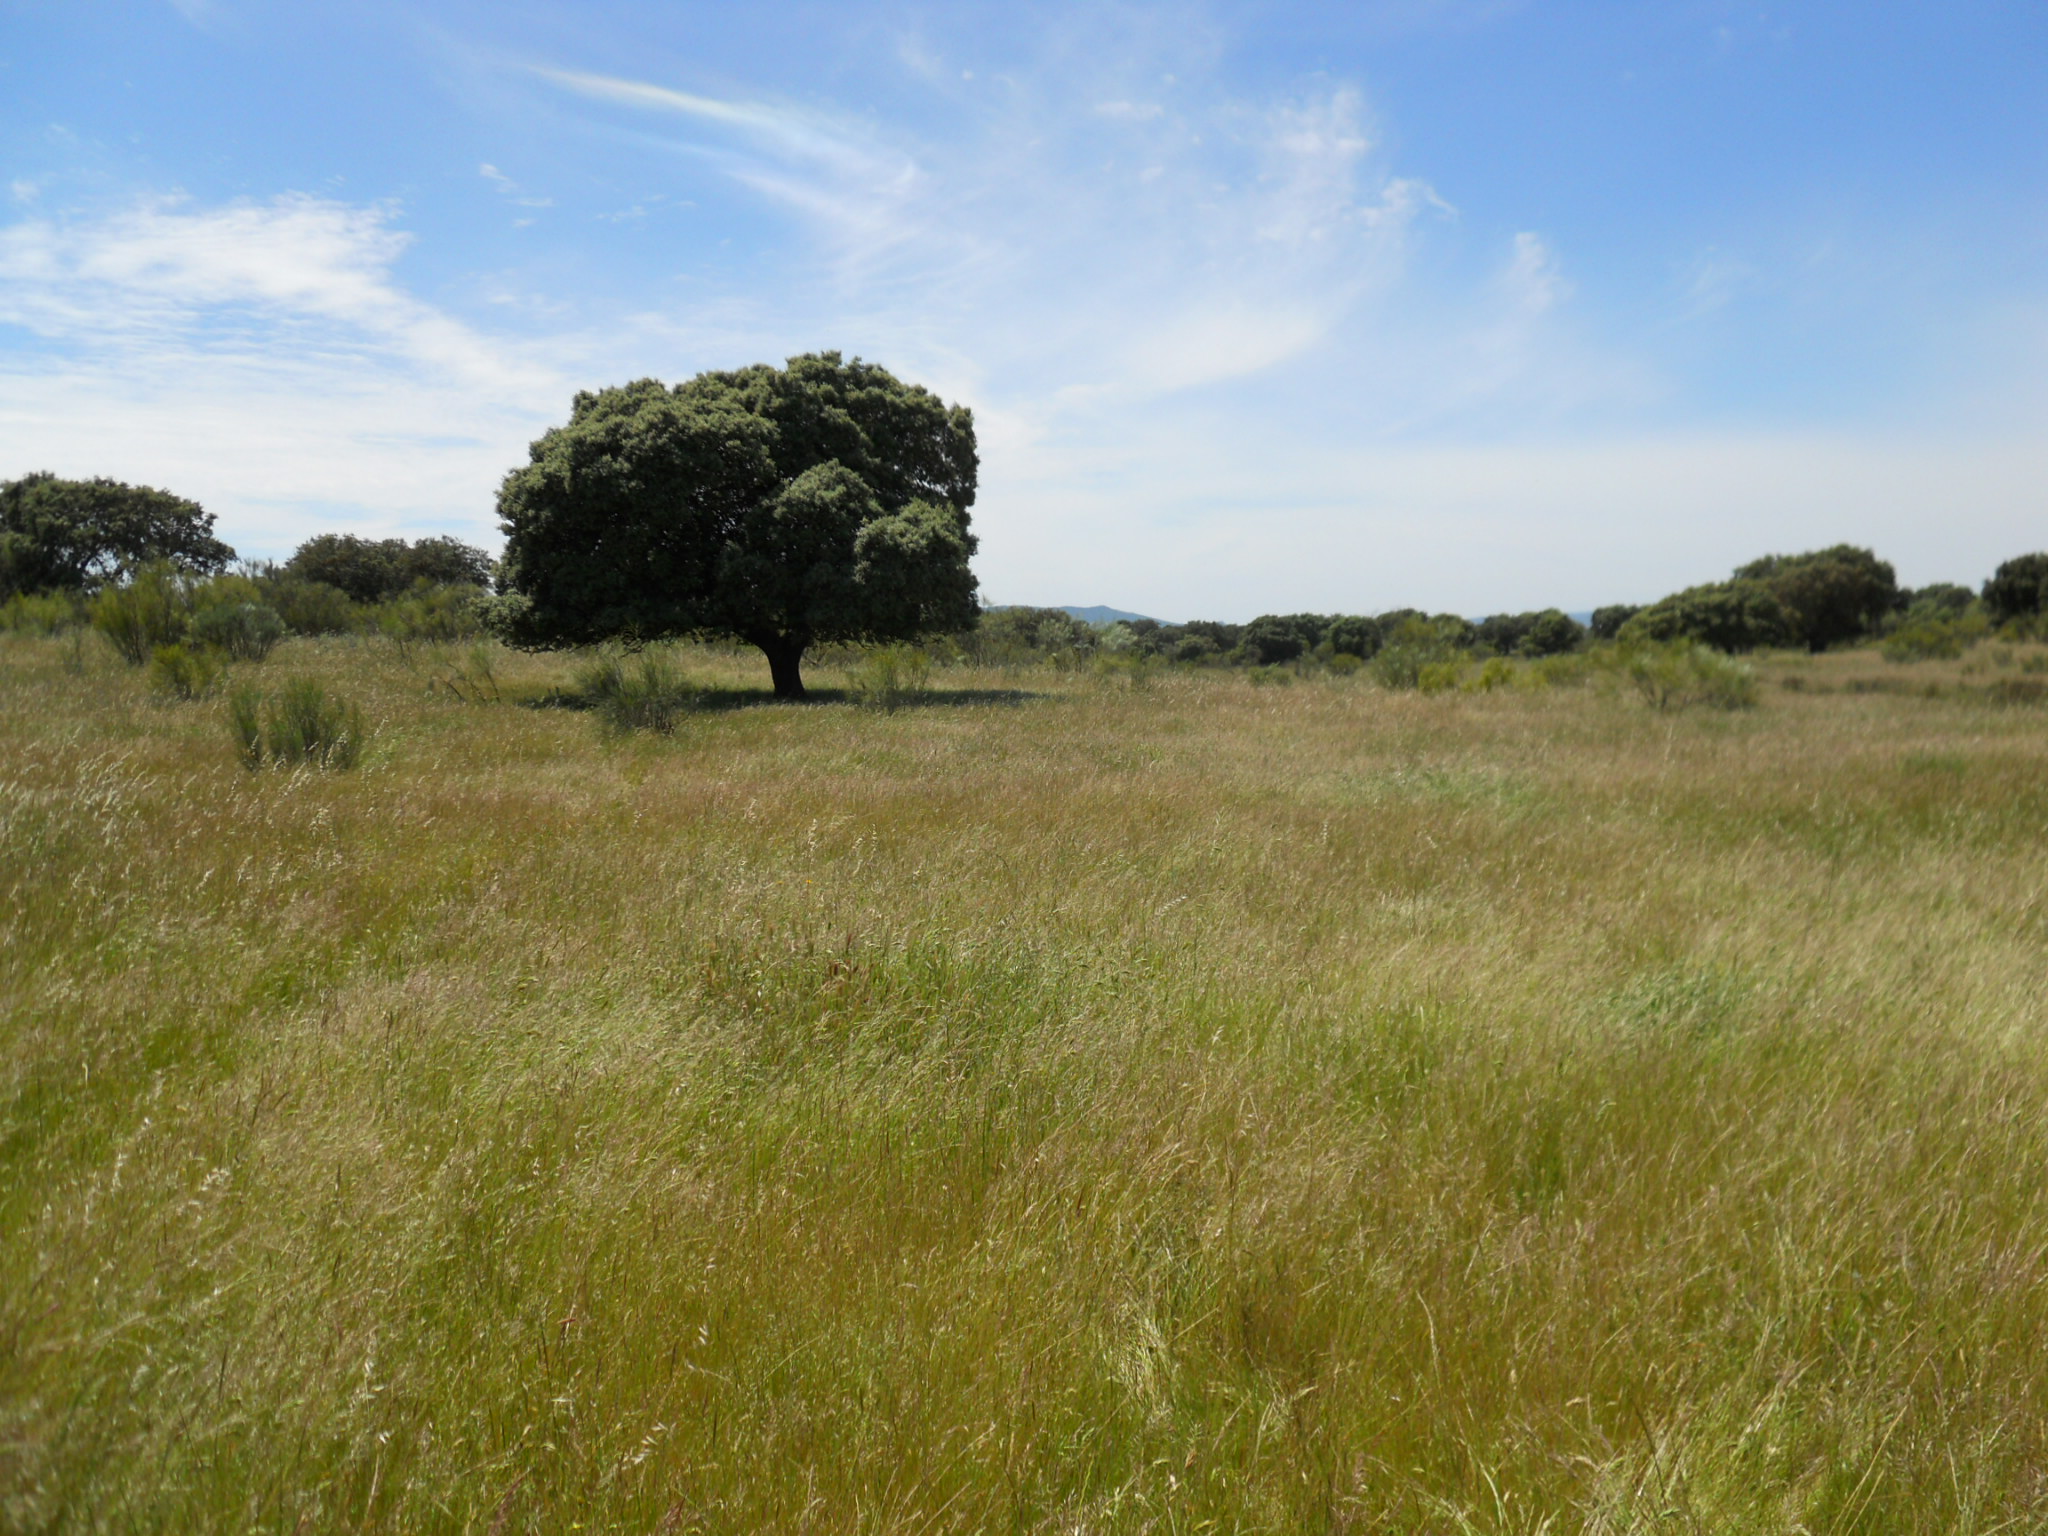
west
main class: Grassland
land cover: Grassland with sparse tree/shrub cover
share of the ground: > 75 %
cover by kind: herbaceous plants 95 %, broadleaved forest trees 5 %
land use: Agriculture (excluding fallow land and kitchen gardens)
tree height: > 5 m
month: May
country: ES
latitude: 39.3113
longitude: -6.3359
